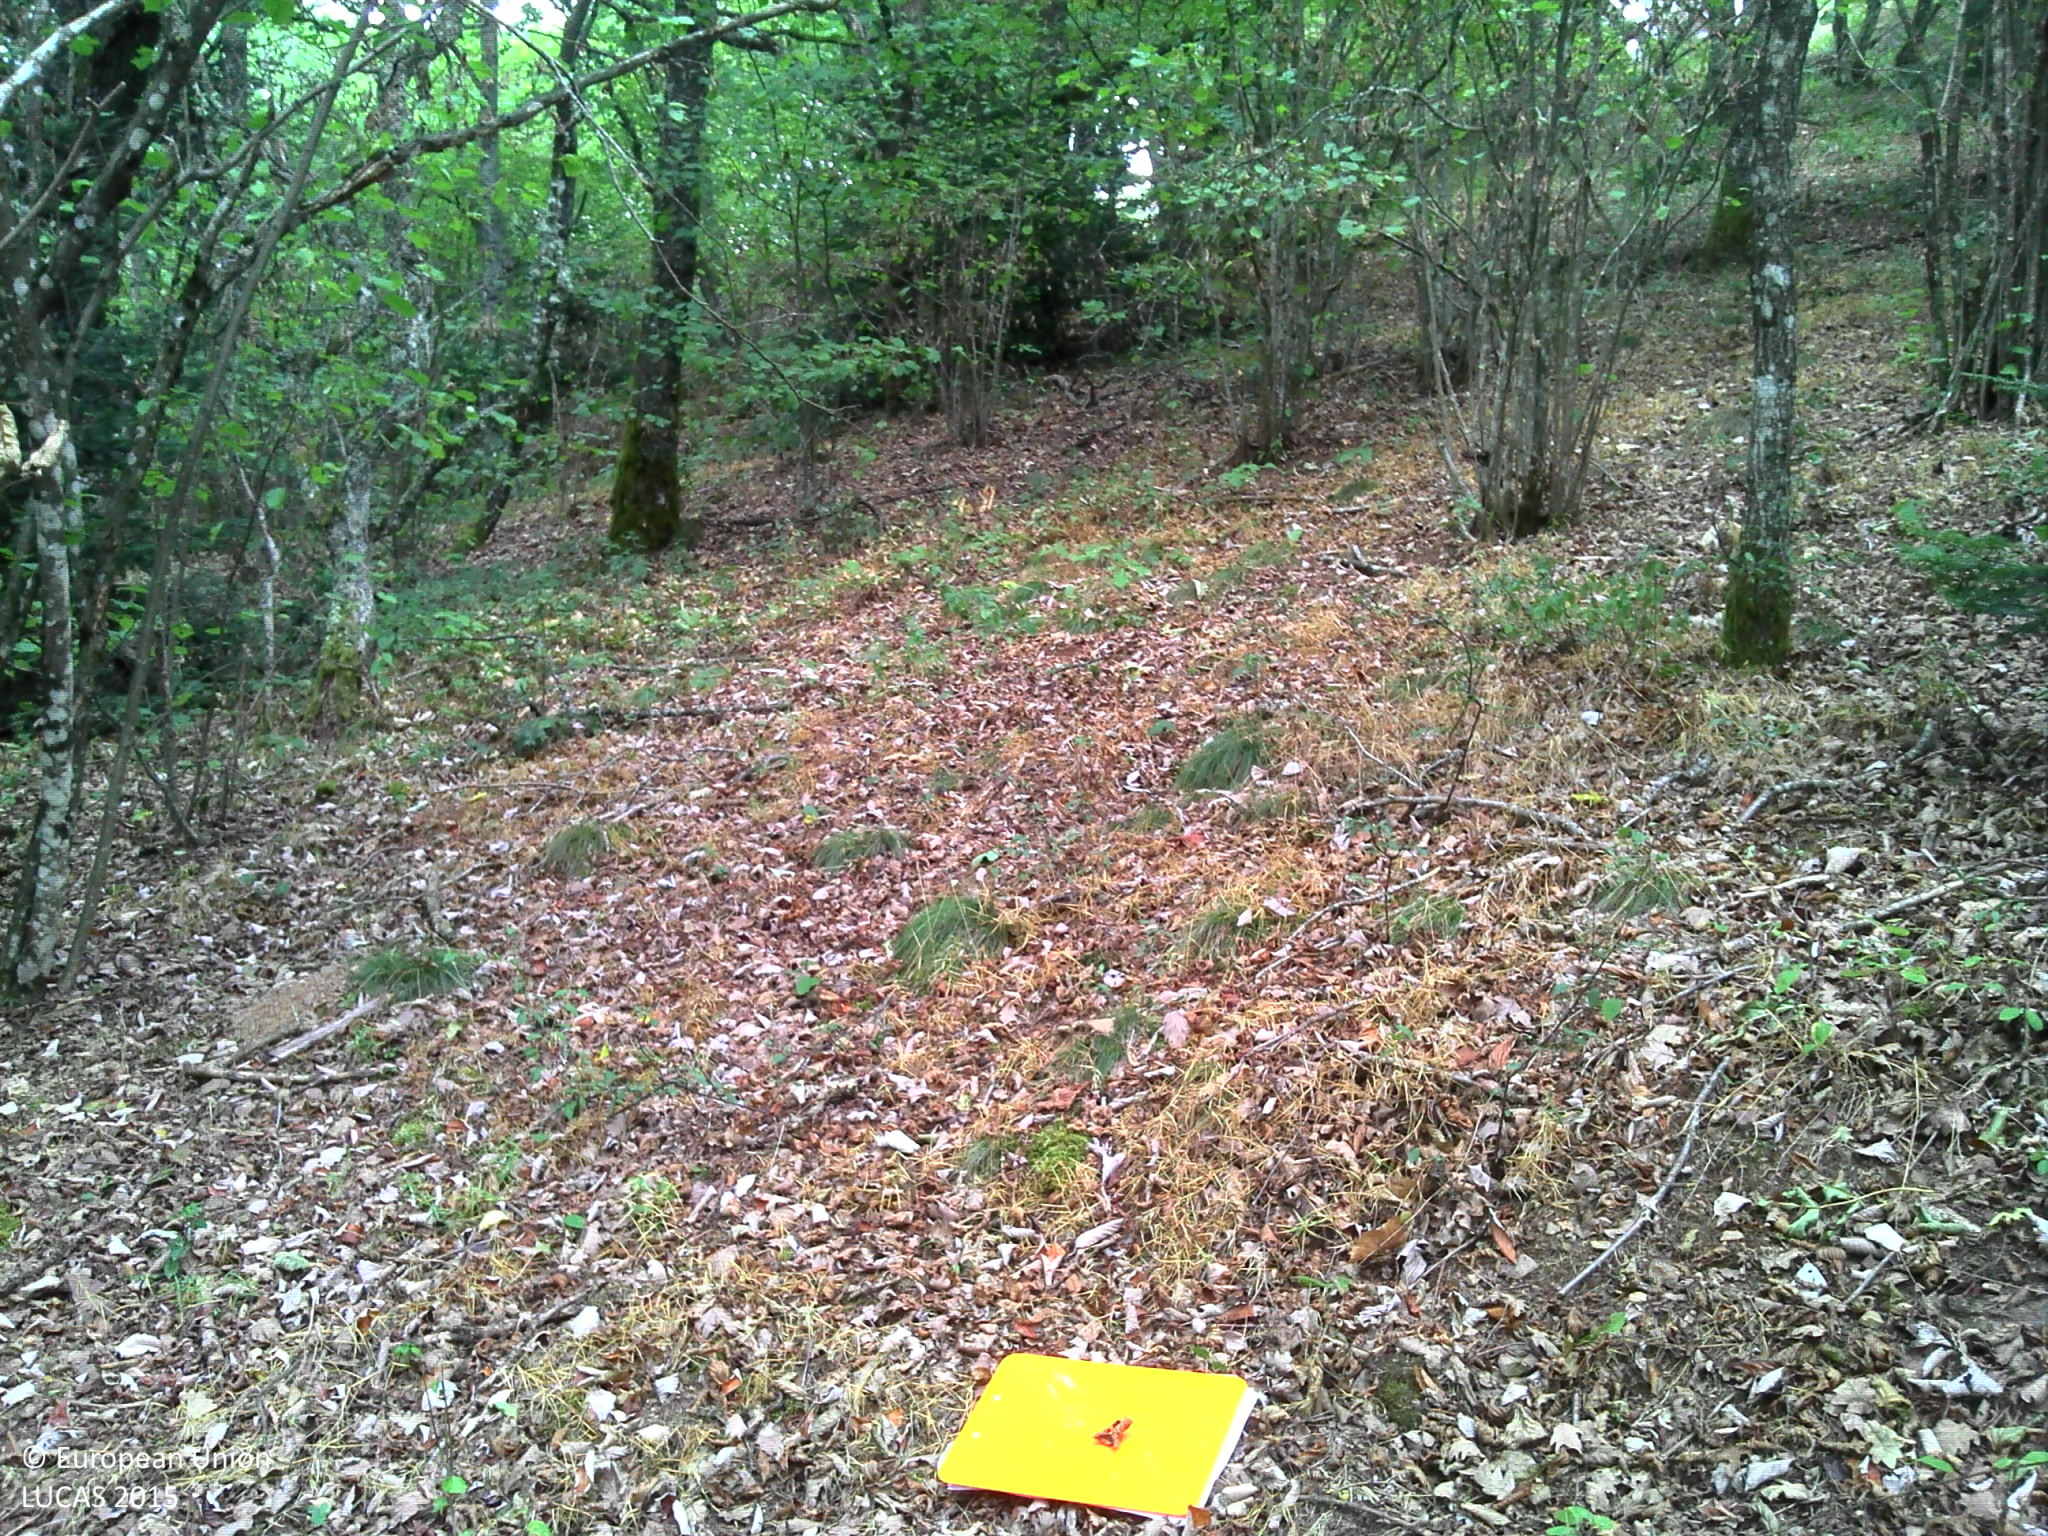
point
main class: Woodland
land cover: Broadleaved woodland
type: mesophytic deciduous forest
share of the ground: > 75 %
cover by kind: broadleaved forest trees 90 %, herbaceous plants 10 %
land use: Forestry
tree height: > 5 m
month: August
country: FR
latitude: 46.0337
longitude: 4.5890
